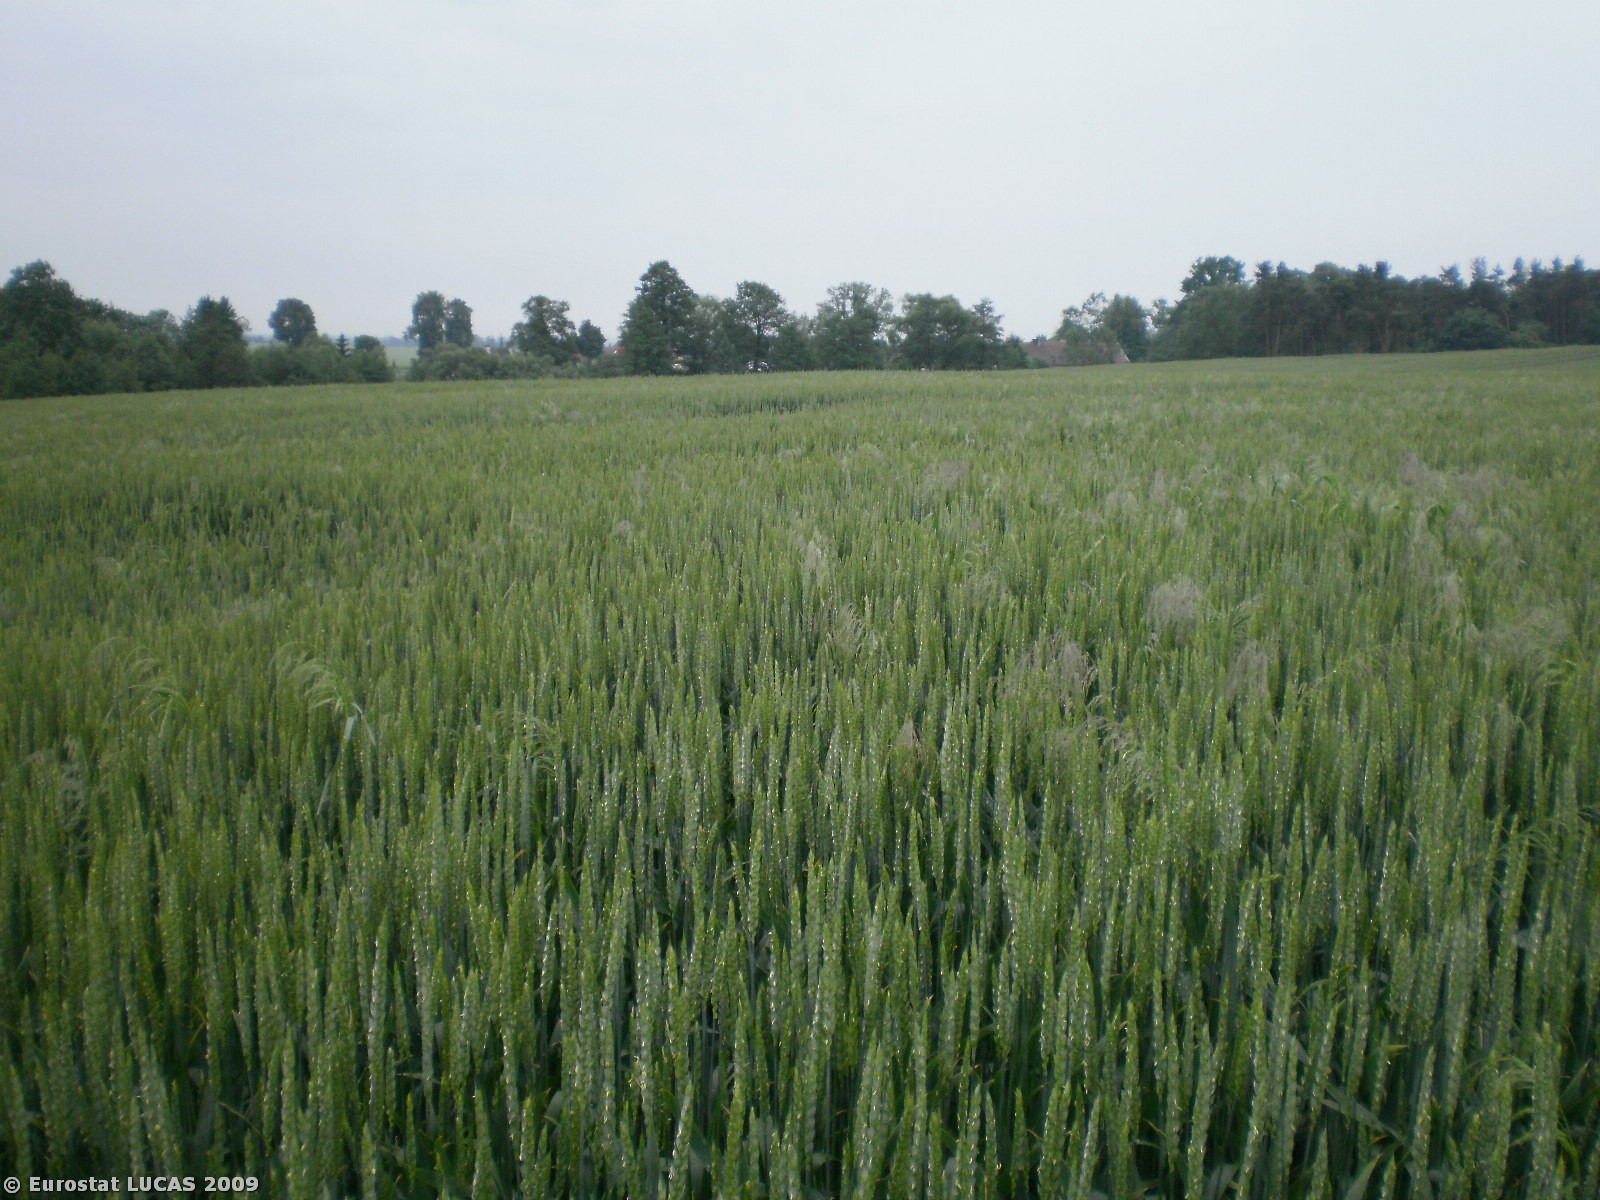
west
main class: Cropland
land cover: Common wheat
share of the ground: > 75 %
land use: Agriculture (excluding fallow land and kitchen gardens)
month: June
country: PL
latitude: 53.6290
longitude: 19.9048
